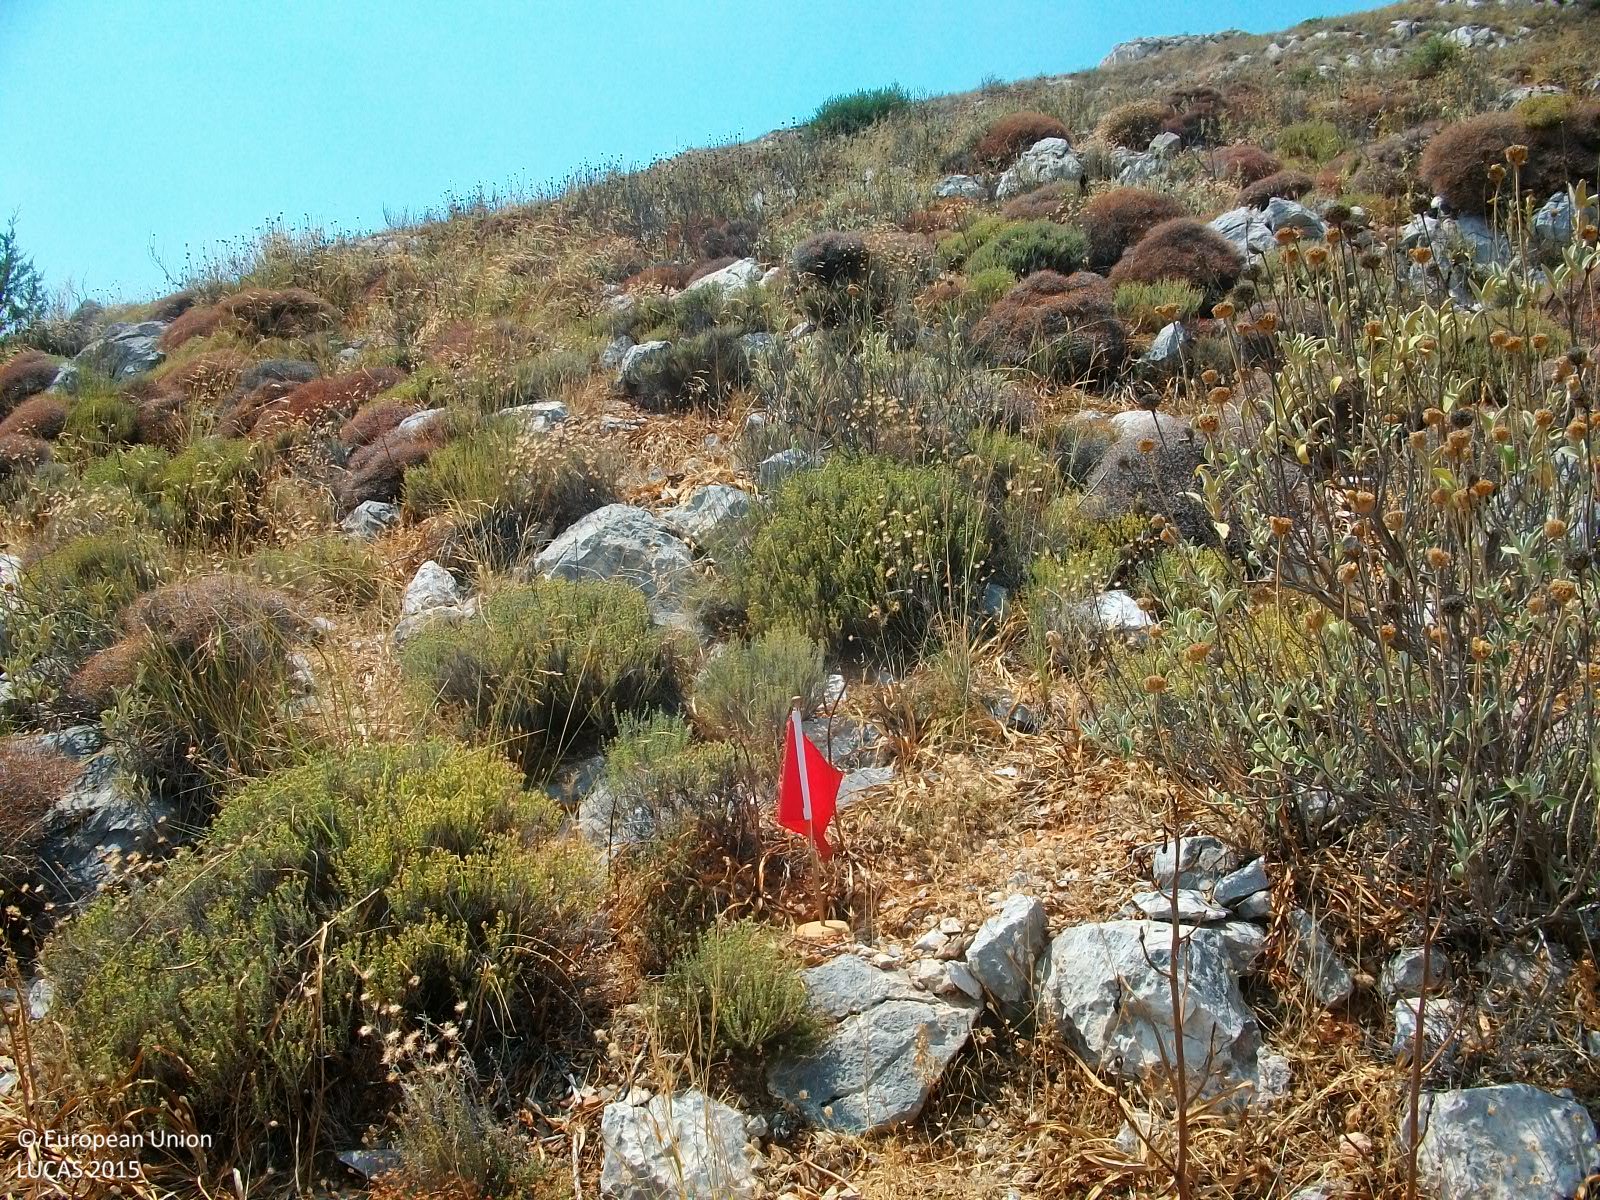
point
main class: Shrubland
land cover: Shrubland without tree cover
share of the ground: 50 - 75 %
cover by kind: shrubs 60 %, herbaceous plants 20 %, consolidated bare surface 20 %
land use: Semi-natural and natural areas not in use
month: July
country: GR
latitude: 37.9908
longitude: 23.6320
